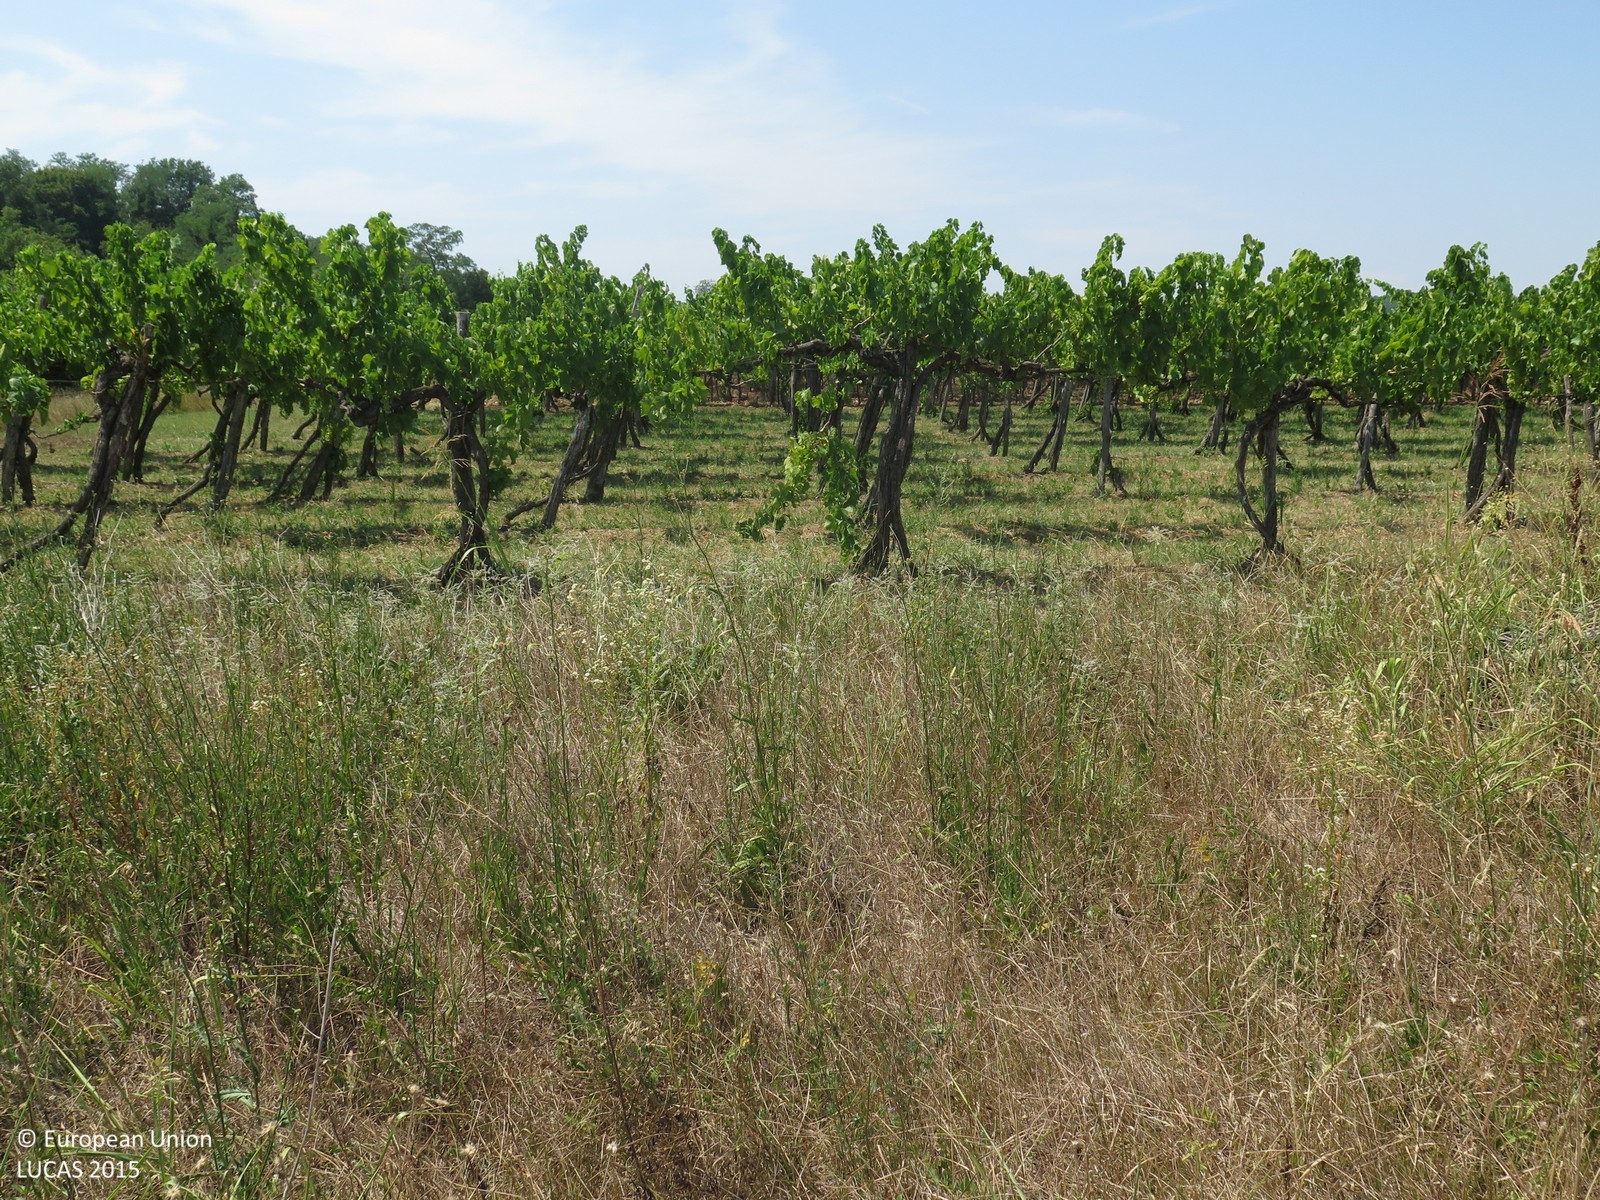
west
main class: Grassland
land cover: Spontaneously vegetated surfaces
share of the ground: > 75 %
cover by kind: herbaceous plants 95 %, shrubs 5 %
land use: Fallow land
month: July
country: HR
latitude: 45.4057
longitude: 13.6365
